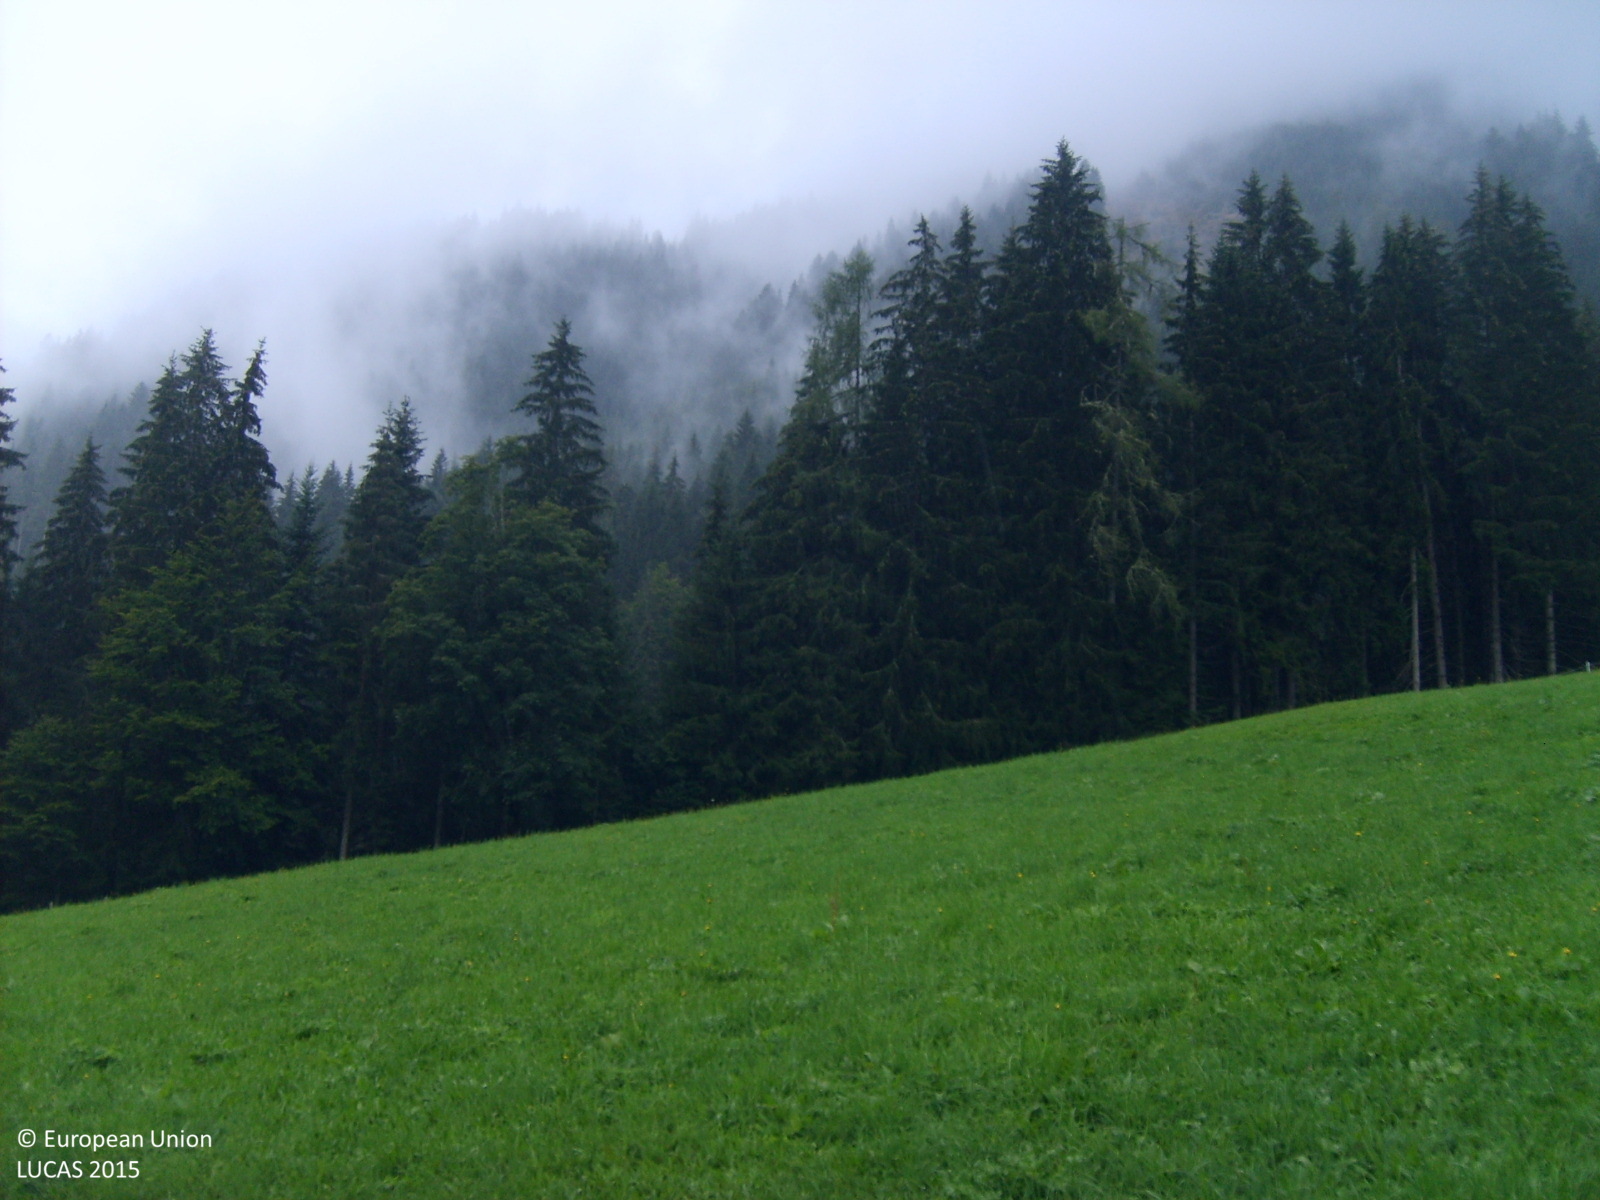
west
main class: Grassland
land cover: Grassland without tree/shrub cover
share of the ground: > 75 %
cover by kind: herbaceous plants 100 %
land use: Agriculture (excluding fallow land and kitchen gardens)
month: September
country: AT
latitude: 47.4357
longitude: 13.2997
